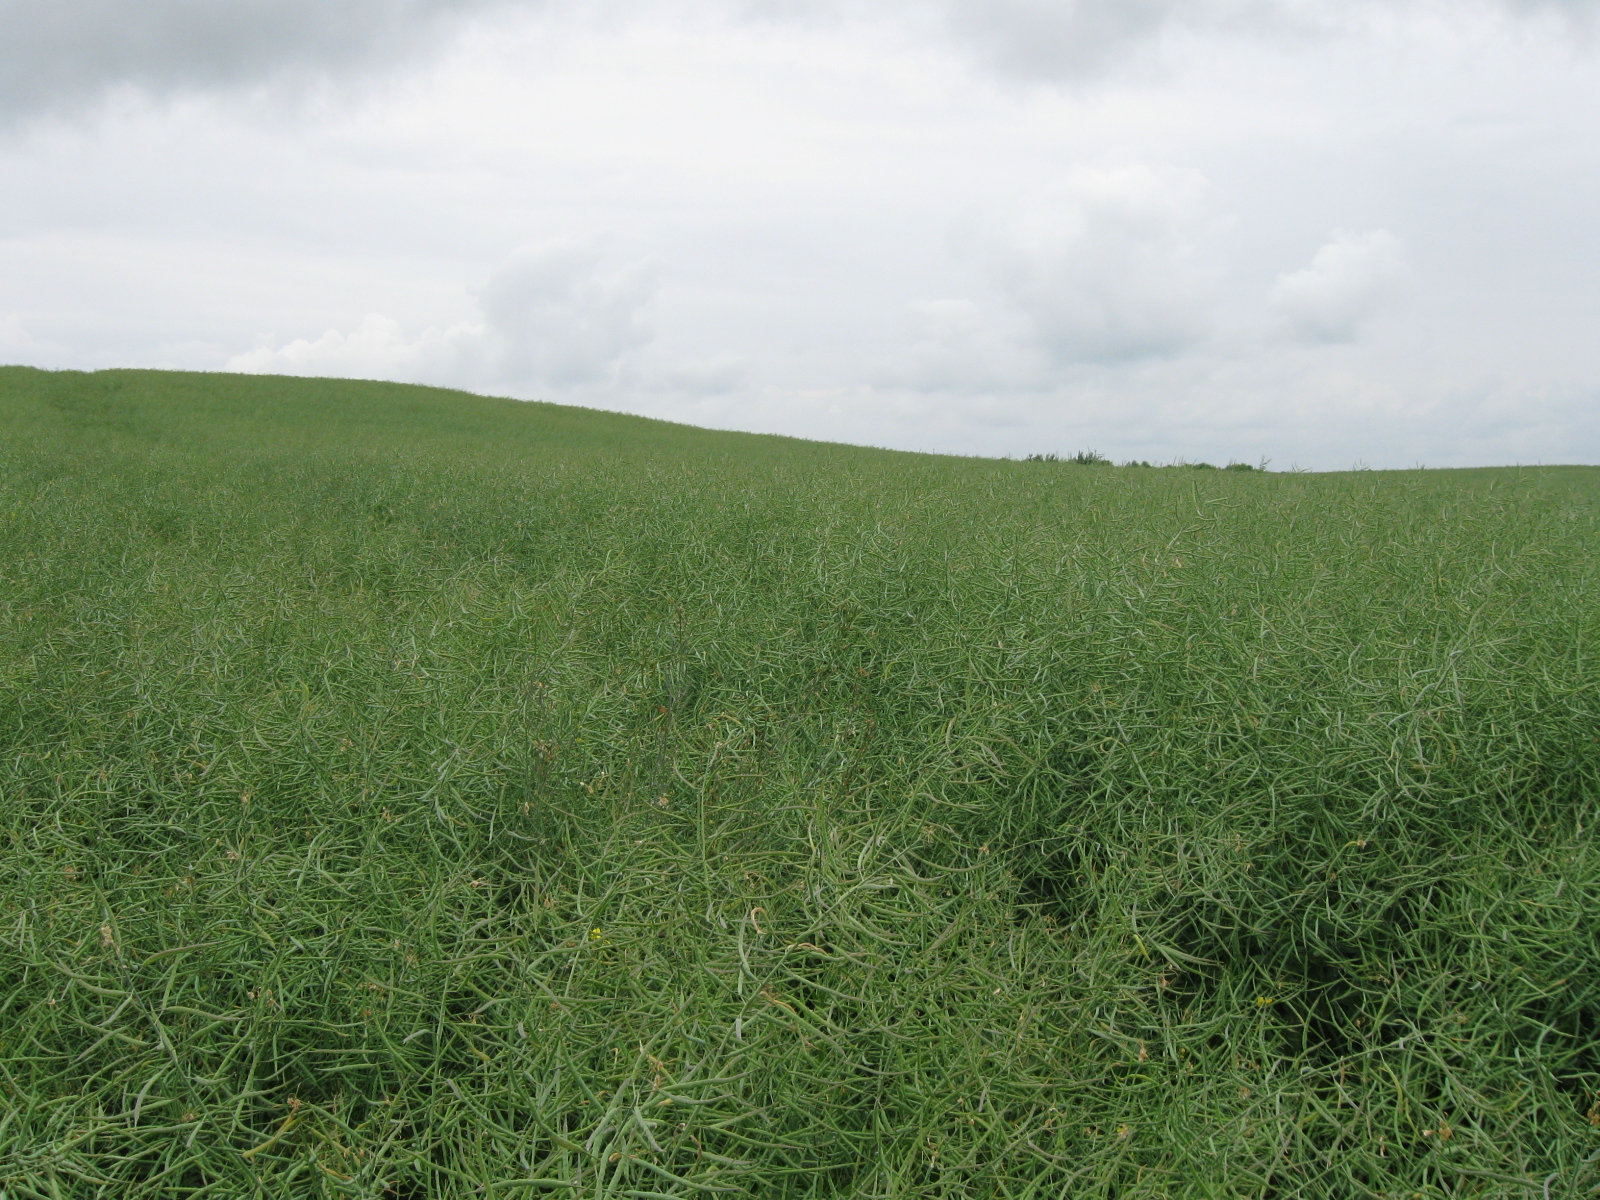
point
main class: Cropland
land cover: Rape and turnip rape
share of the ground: > 75 %
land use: Agriculture (excluding fallow land and kitchen gardens)
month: June
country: LT
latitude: 54.8937
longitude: 24.5569
